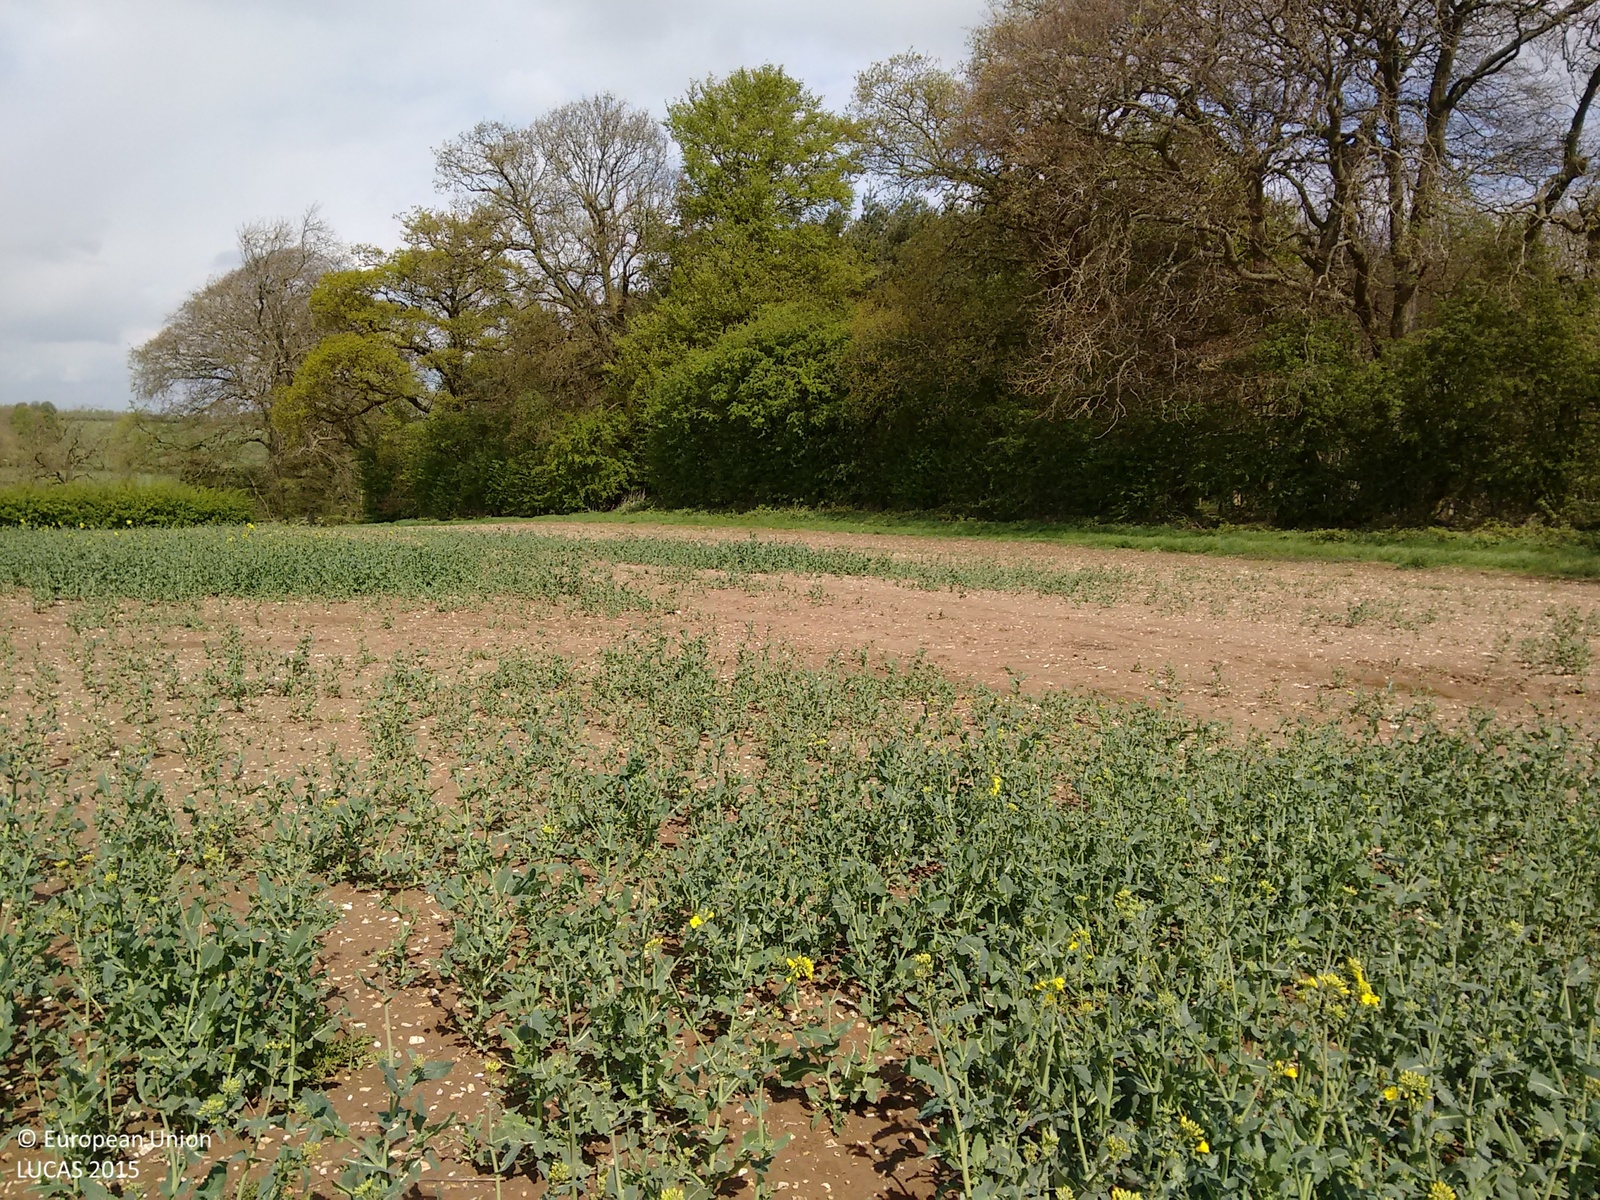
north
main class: Cropland
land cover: Rape and turnip rape
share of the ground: 50 - 75 %
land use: Agriculture (excluding fallow land and kitchen gardens)
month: May
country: GB
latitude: 53.3529
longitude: -0.1746
